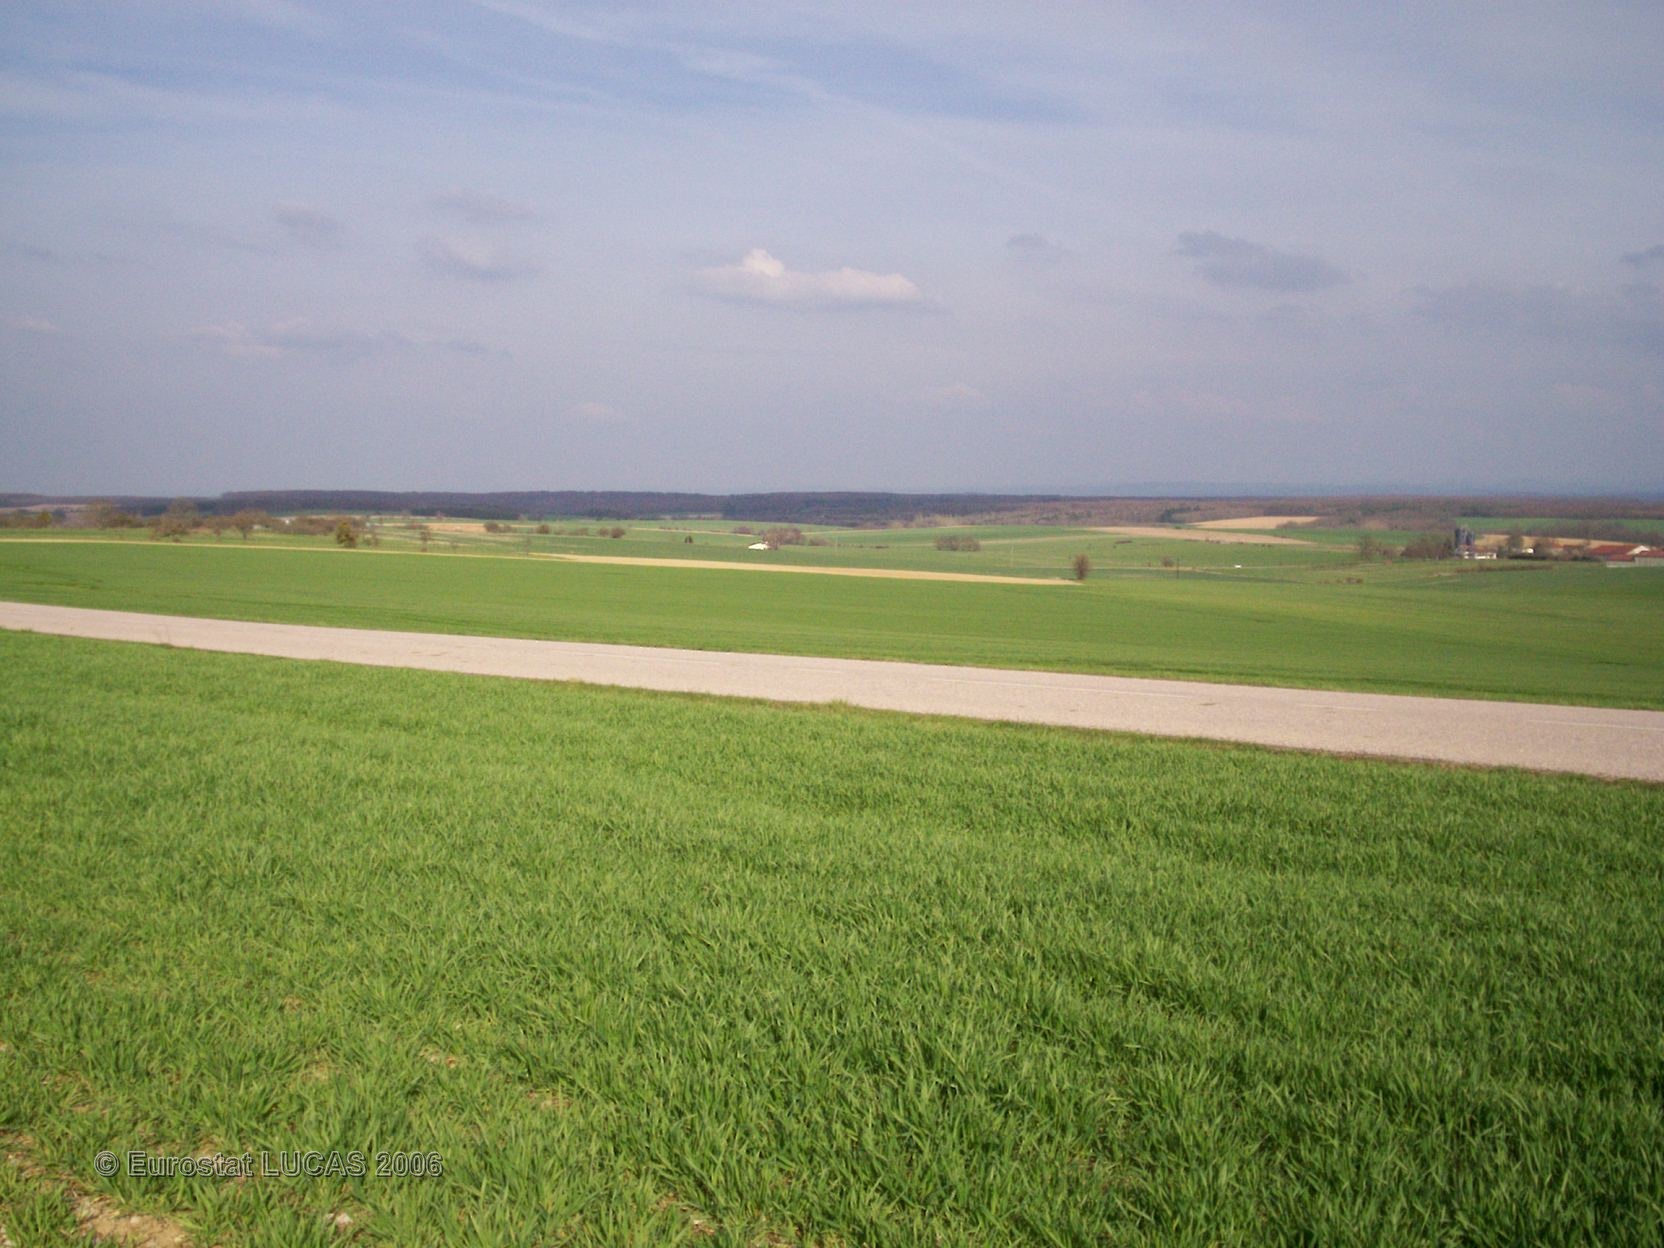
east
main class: Cropland
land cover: Common wheat
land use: Agriculture (excluding fallow land and kitchen gardens)
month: April
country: FR
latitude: 48.2344
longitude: 6.3250
